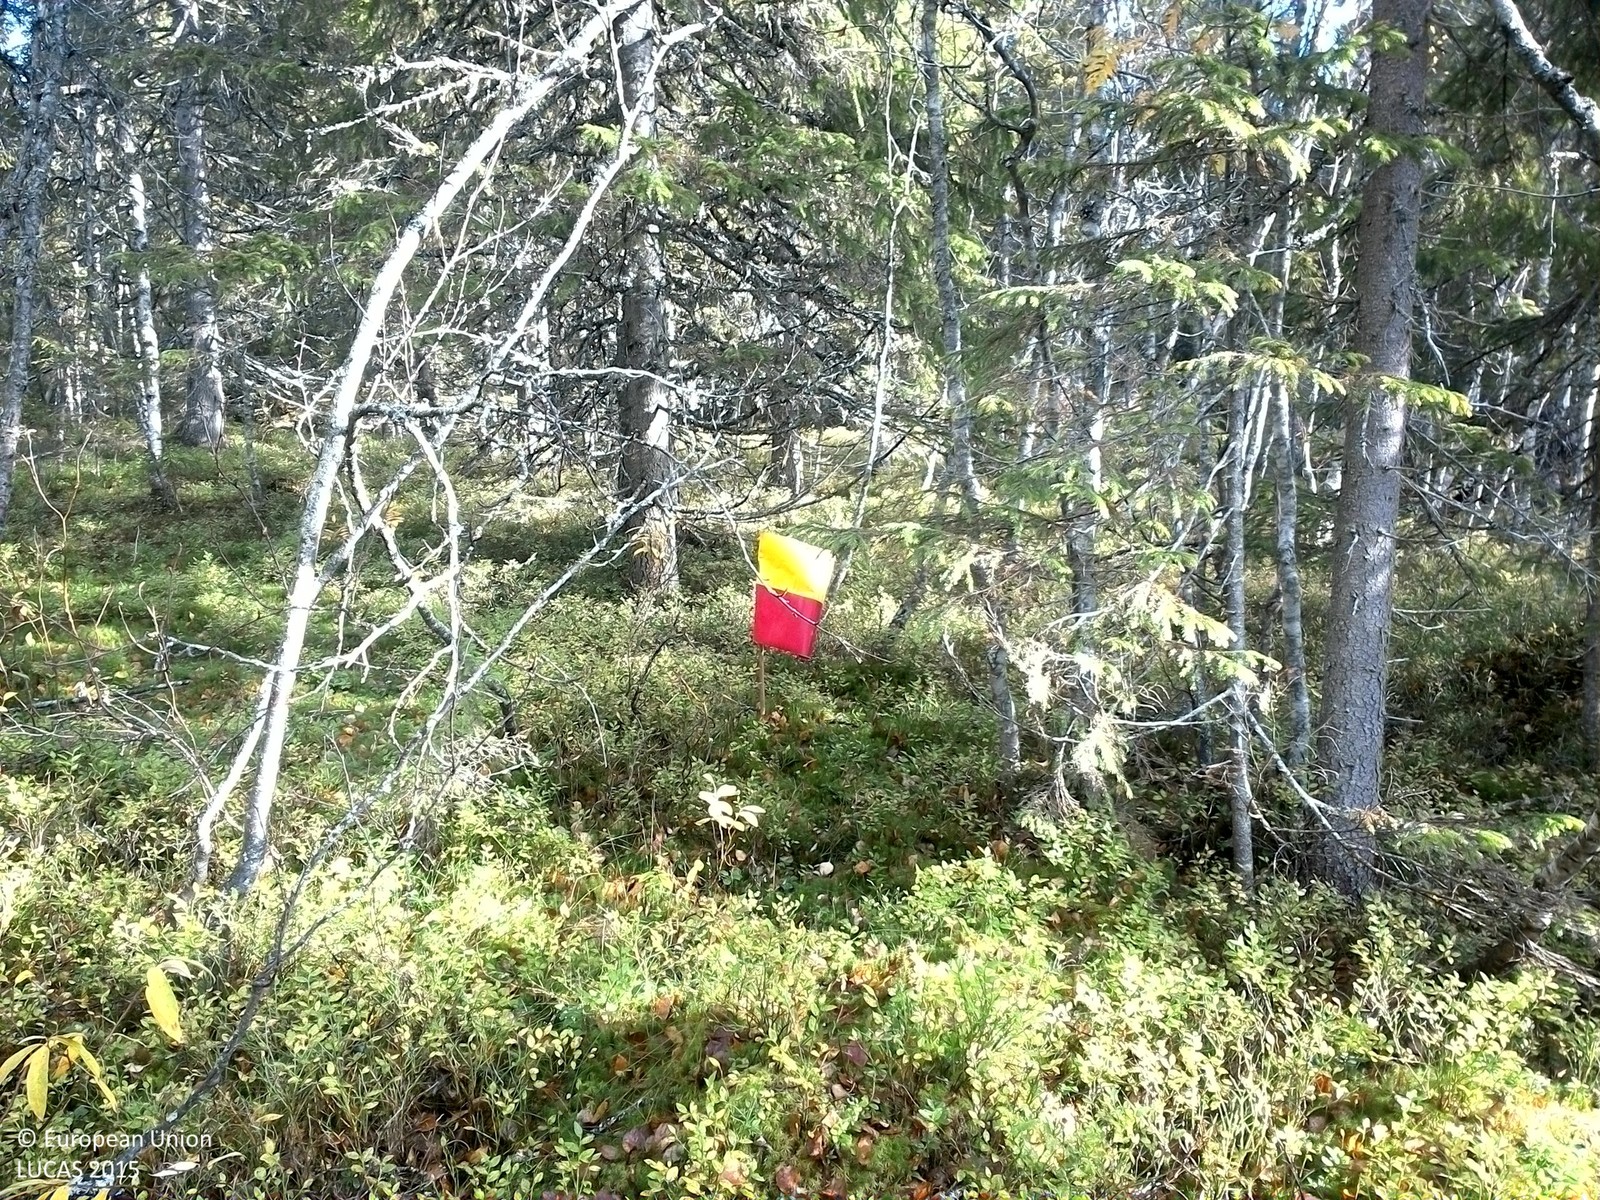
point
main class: Woodland
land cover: Spruce dominated coniferous woodland
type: boreal forest
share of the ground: 50 - 75 %
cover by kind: coniferous forest trees 50 %, shrubs 20 %, broadleaved forest trees 15 %, lichens and mosses 15 %
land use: Forestry
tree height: > 5 m
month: October
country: SE
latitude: 64.2120
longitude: 16.0068
